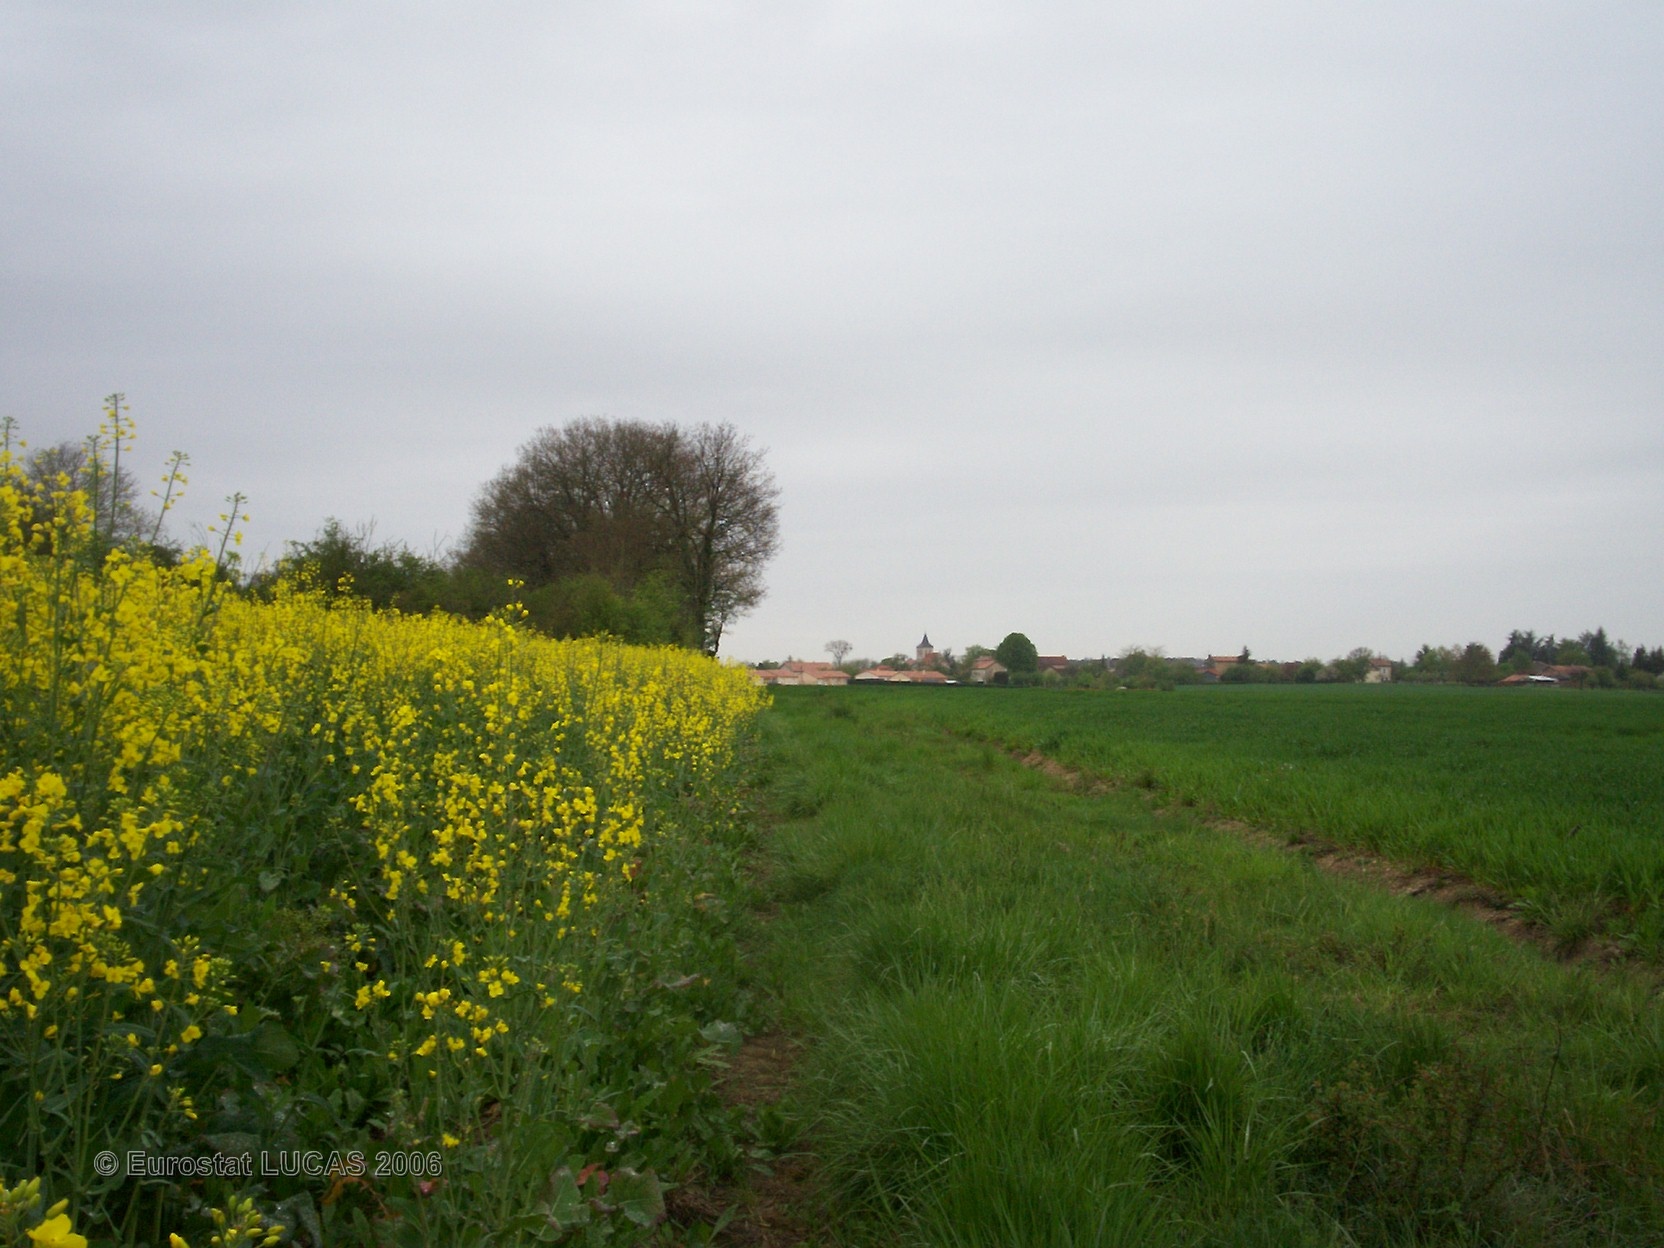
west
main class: Cropland
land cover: Rape and turnip rape
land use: Agriculture (excluding fallow land and kitchen gardens)
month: April
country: FR
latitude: 46.5331
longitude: 0.5826
